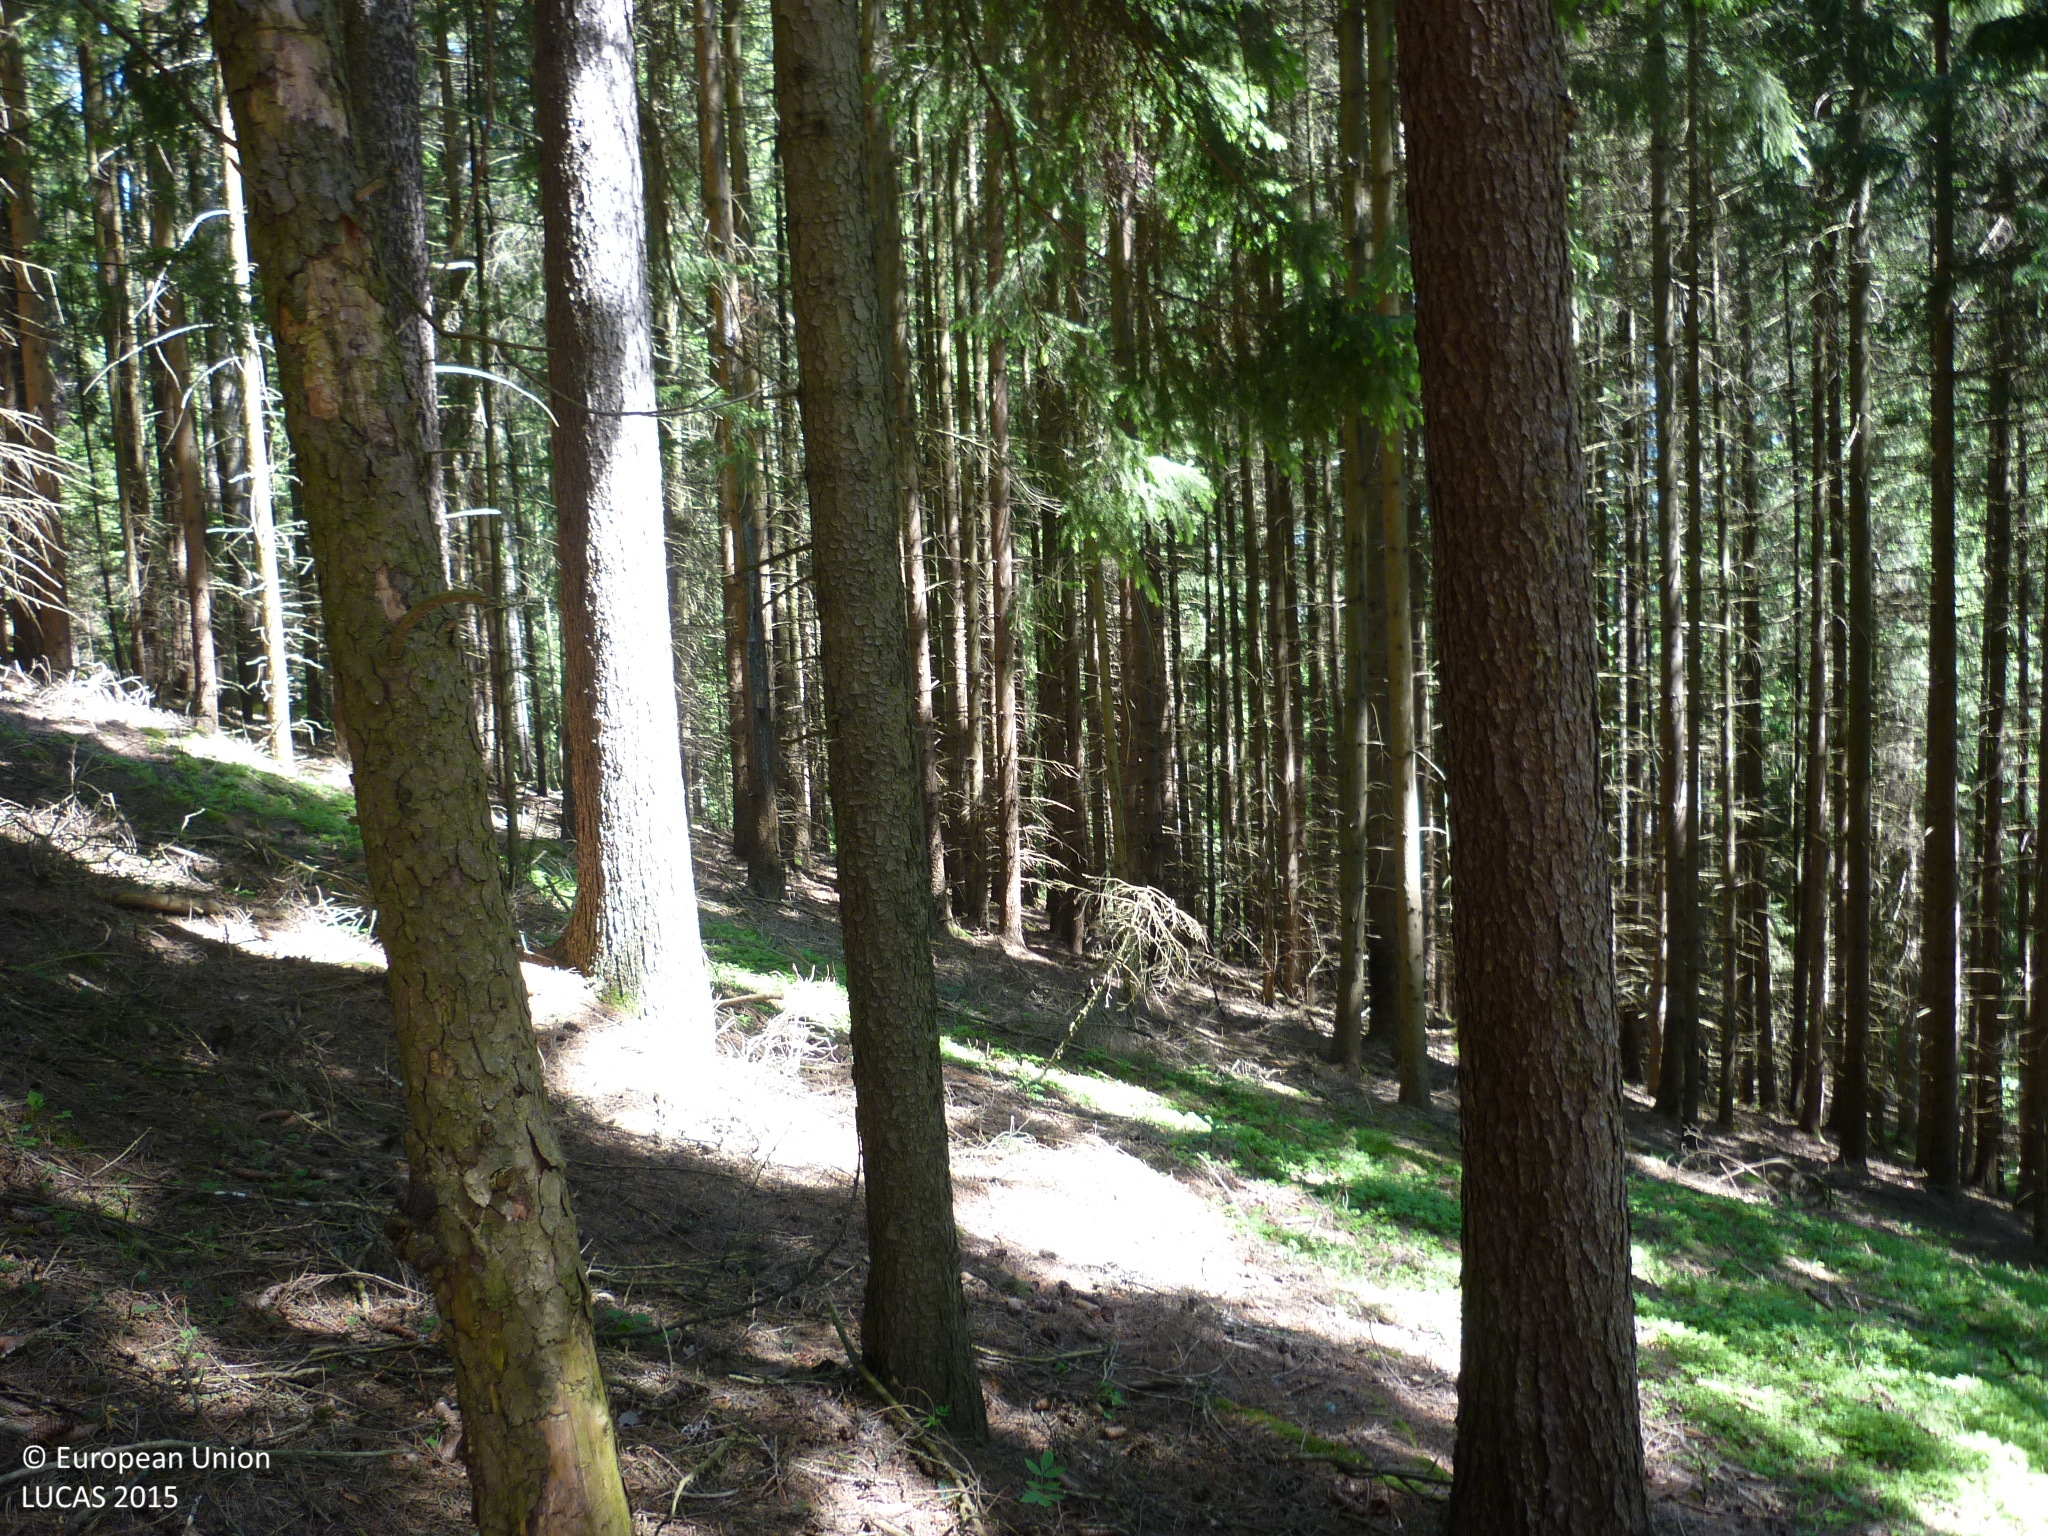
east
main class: Woodland
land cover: Spruce dominated coniferous woodland
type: alpine coniferous forest
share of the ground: > 75 %
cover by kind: coniferous forest trees 95 %, herbaceous plants 5 %
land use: Forestry
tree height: > 5 m
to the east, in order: Spruce dominated coniferous woodland; Tracks; Spruce dominated coniferous woodland; Tracks; Spruce dominated coniferous woodland; Grassland without tree/shrub cover
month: May
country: AT
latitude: 47.3030
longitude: 14.9062
